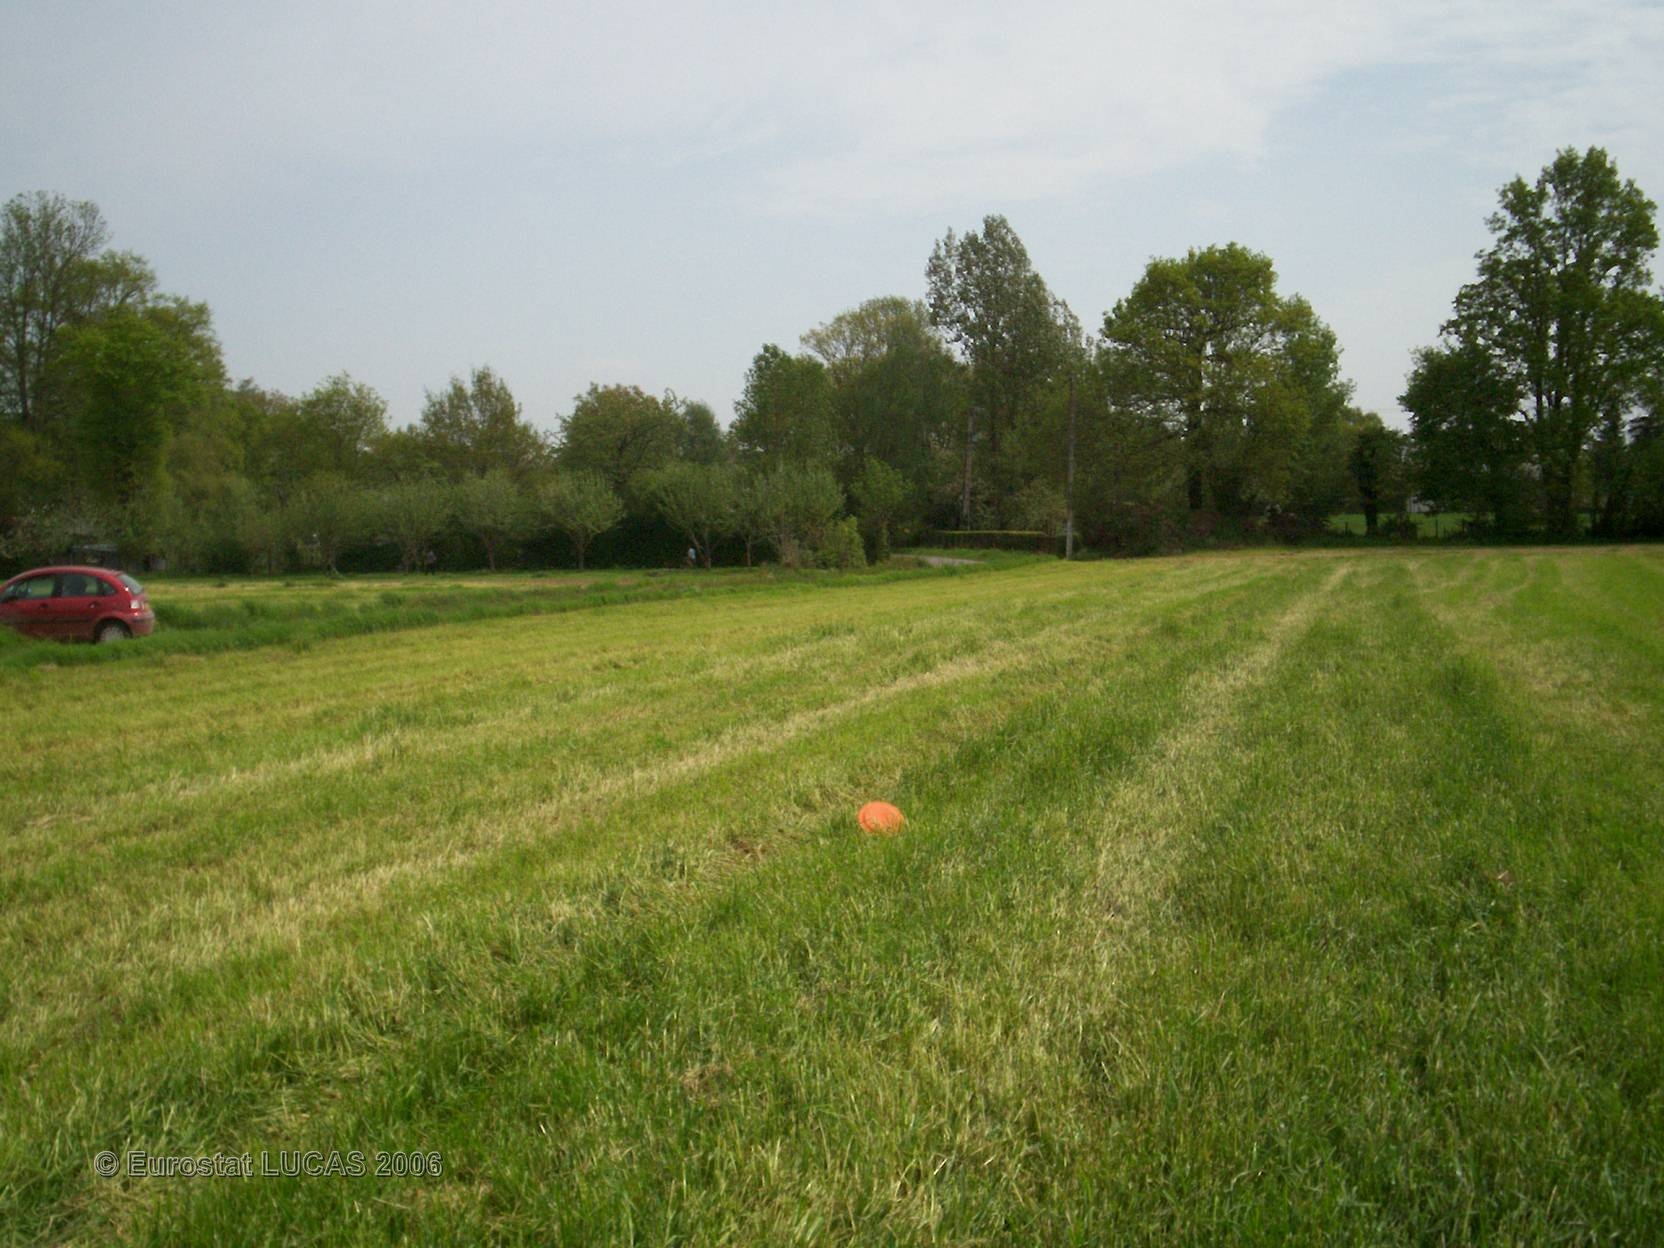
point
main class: Grassland
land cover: Grassland without tree/shrub cover
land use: Agriculture (excluding fallow land and kitchen gardens)
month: May
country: FR
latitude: 47.7221
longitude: -2.2255
